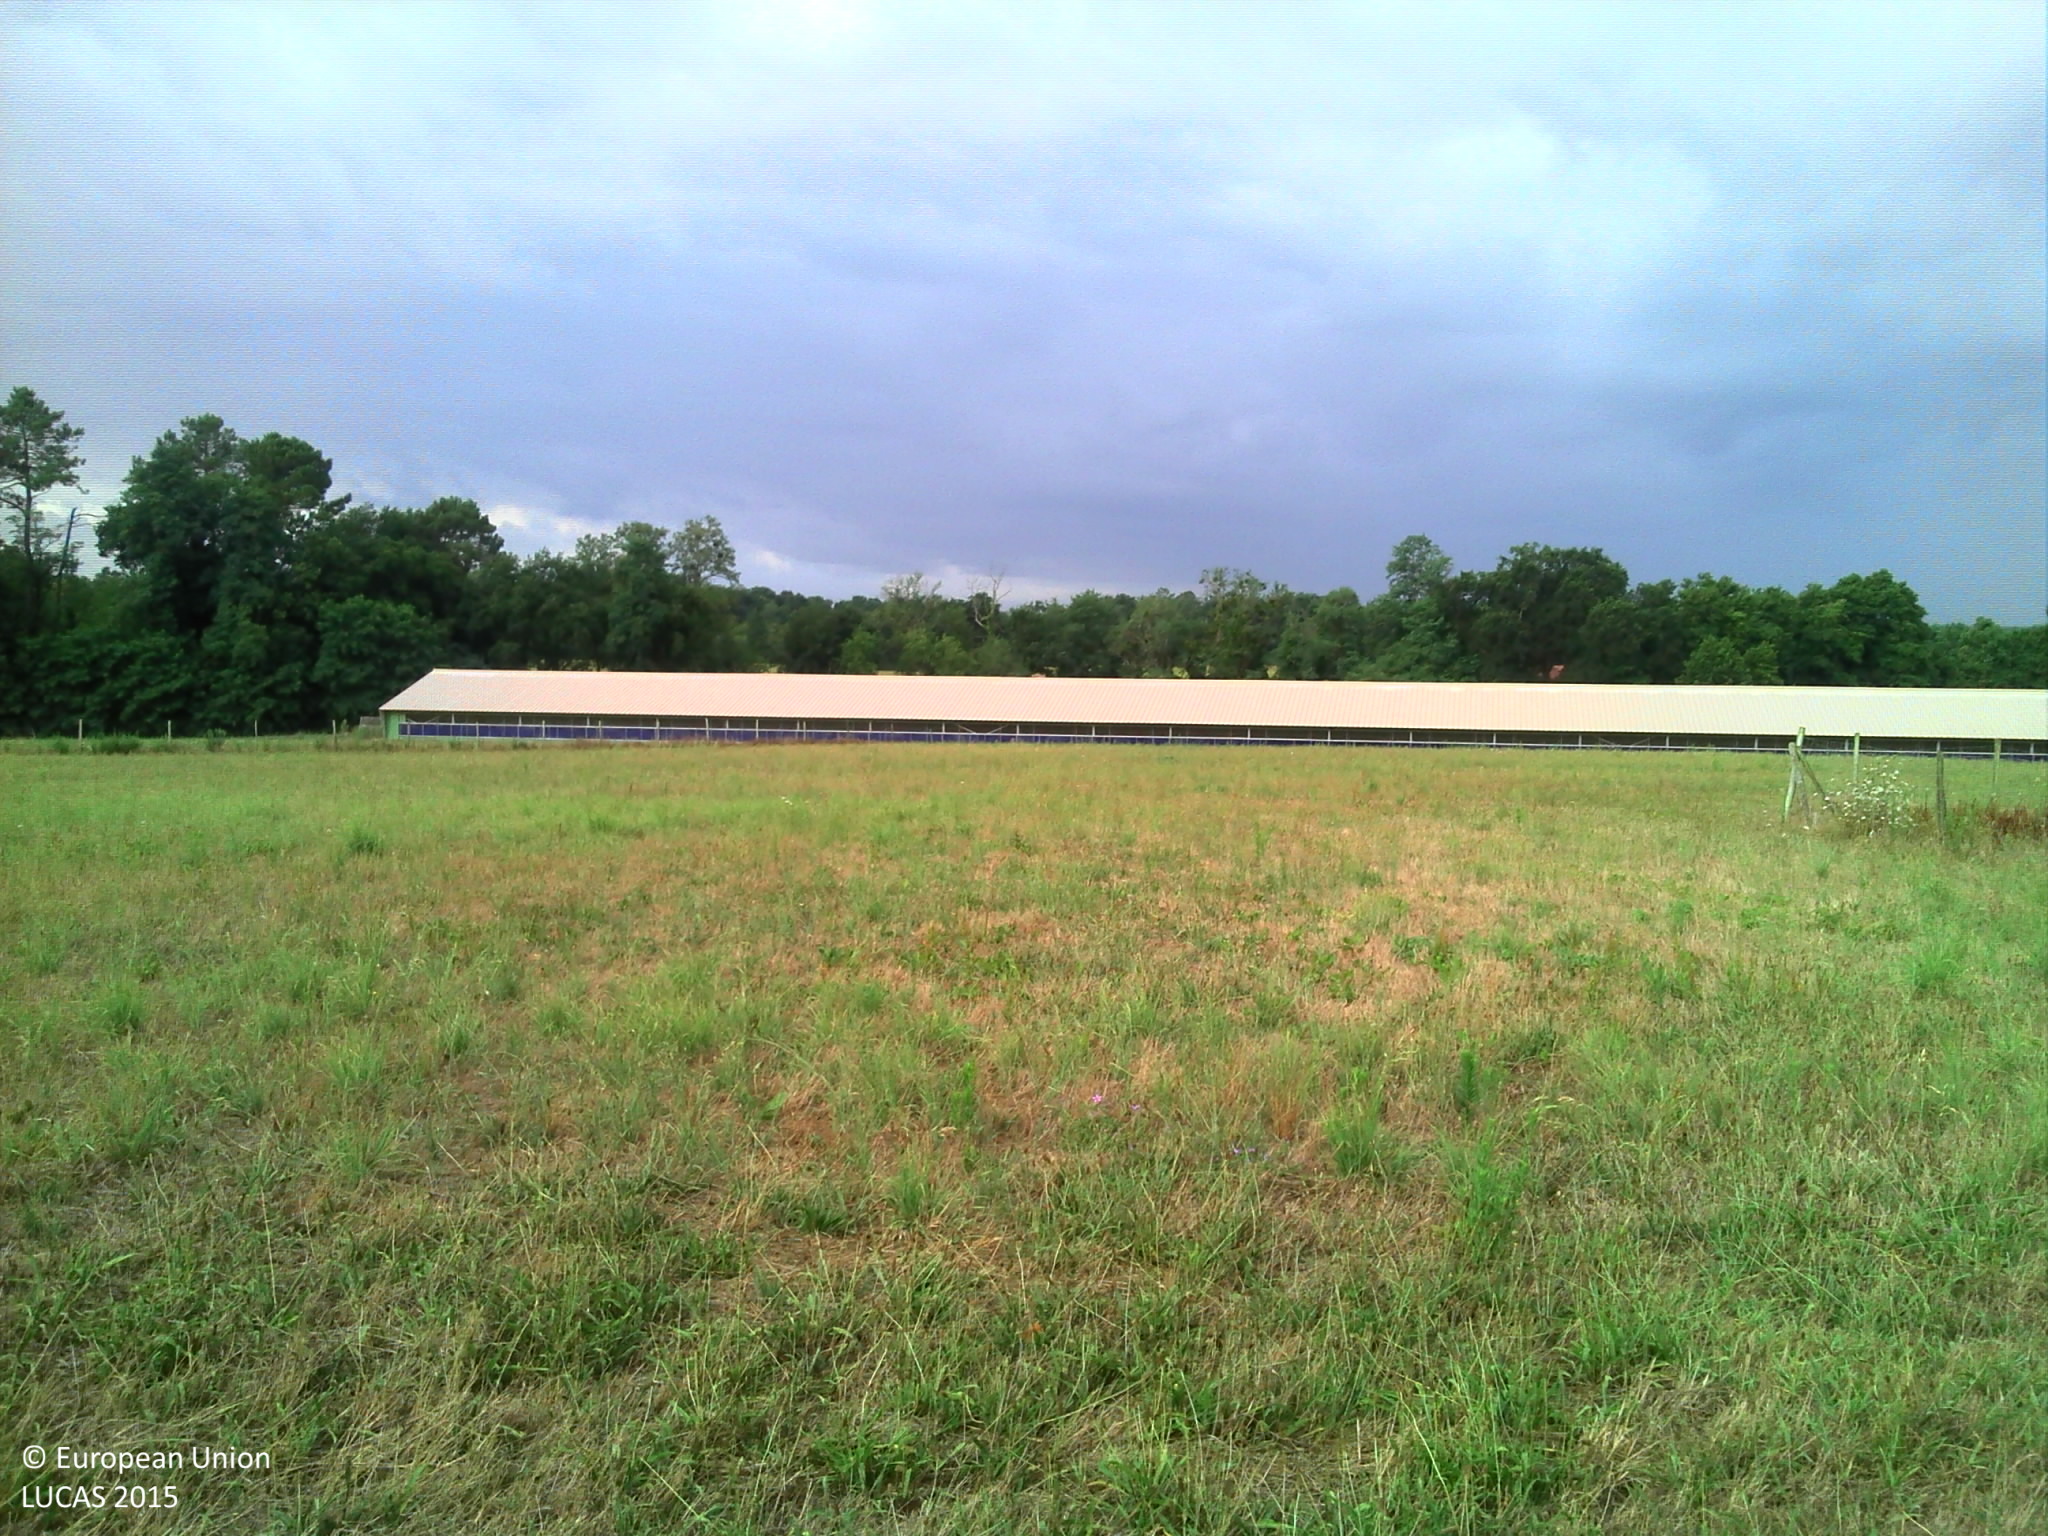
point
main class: Grassland
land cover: Grassland without tree/shrub cover
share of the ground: > 75 %
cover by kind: herbaceous plants 100 %
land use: Agriculture (excluding fallow land and kitchen gardens)
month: July
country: FR
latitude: 43.8196
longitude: -0.8187
